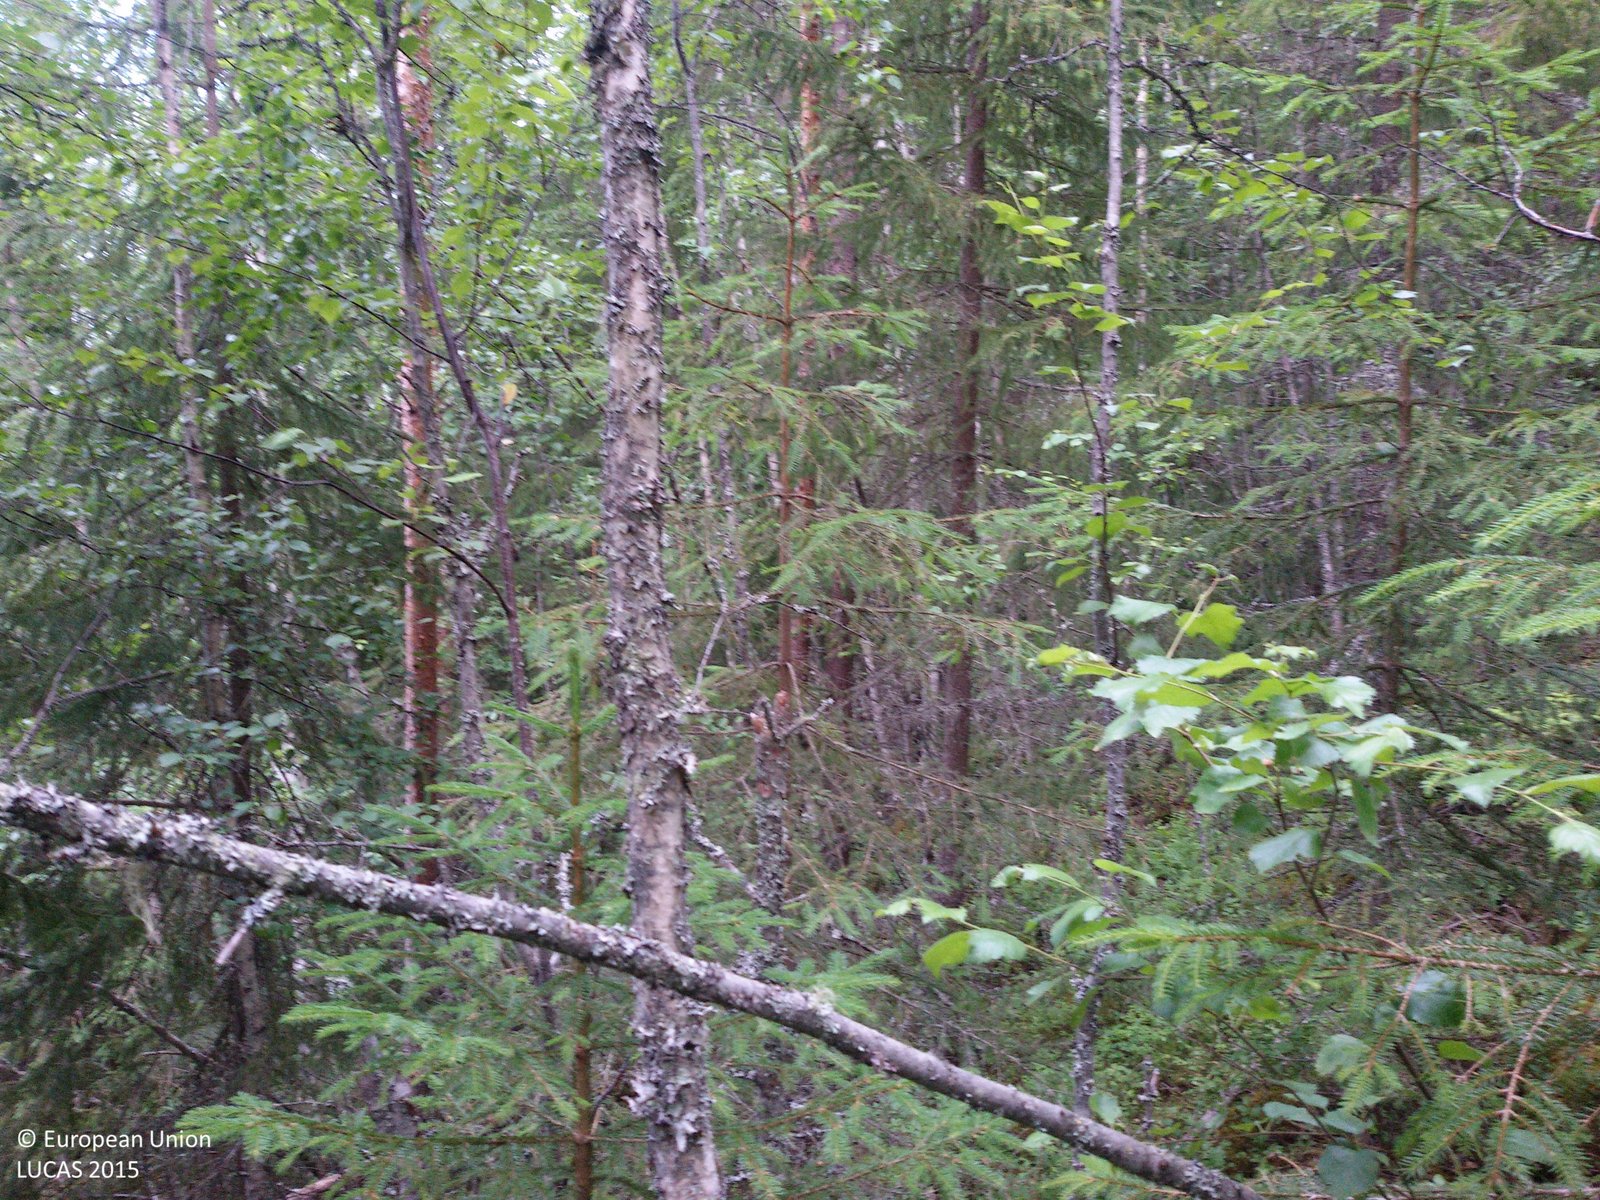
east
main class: Woodland
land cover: Spruce dominated mixed woodland
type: boreal forest
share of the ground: > 75 %
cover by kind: coniferous forest trees 70 %, broadleaved forest trees 30 %
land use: Forestry
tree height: > 5 m
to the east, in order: Spruce dominated mixed woodland
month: July
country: SE
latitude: 60.4379
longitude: 14.9123
